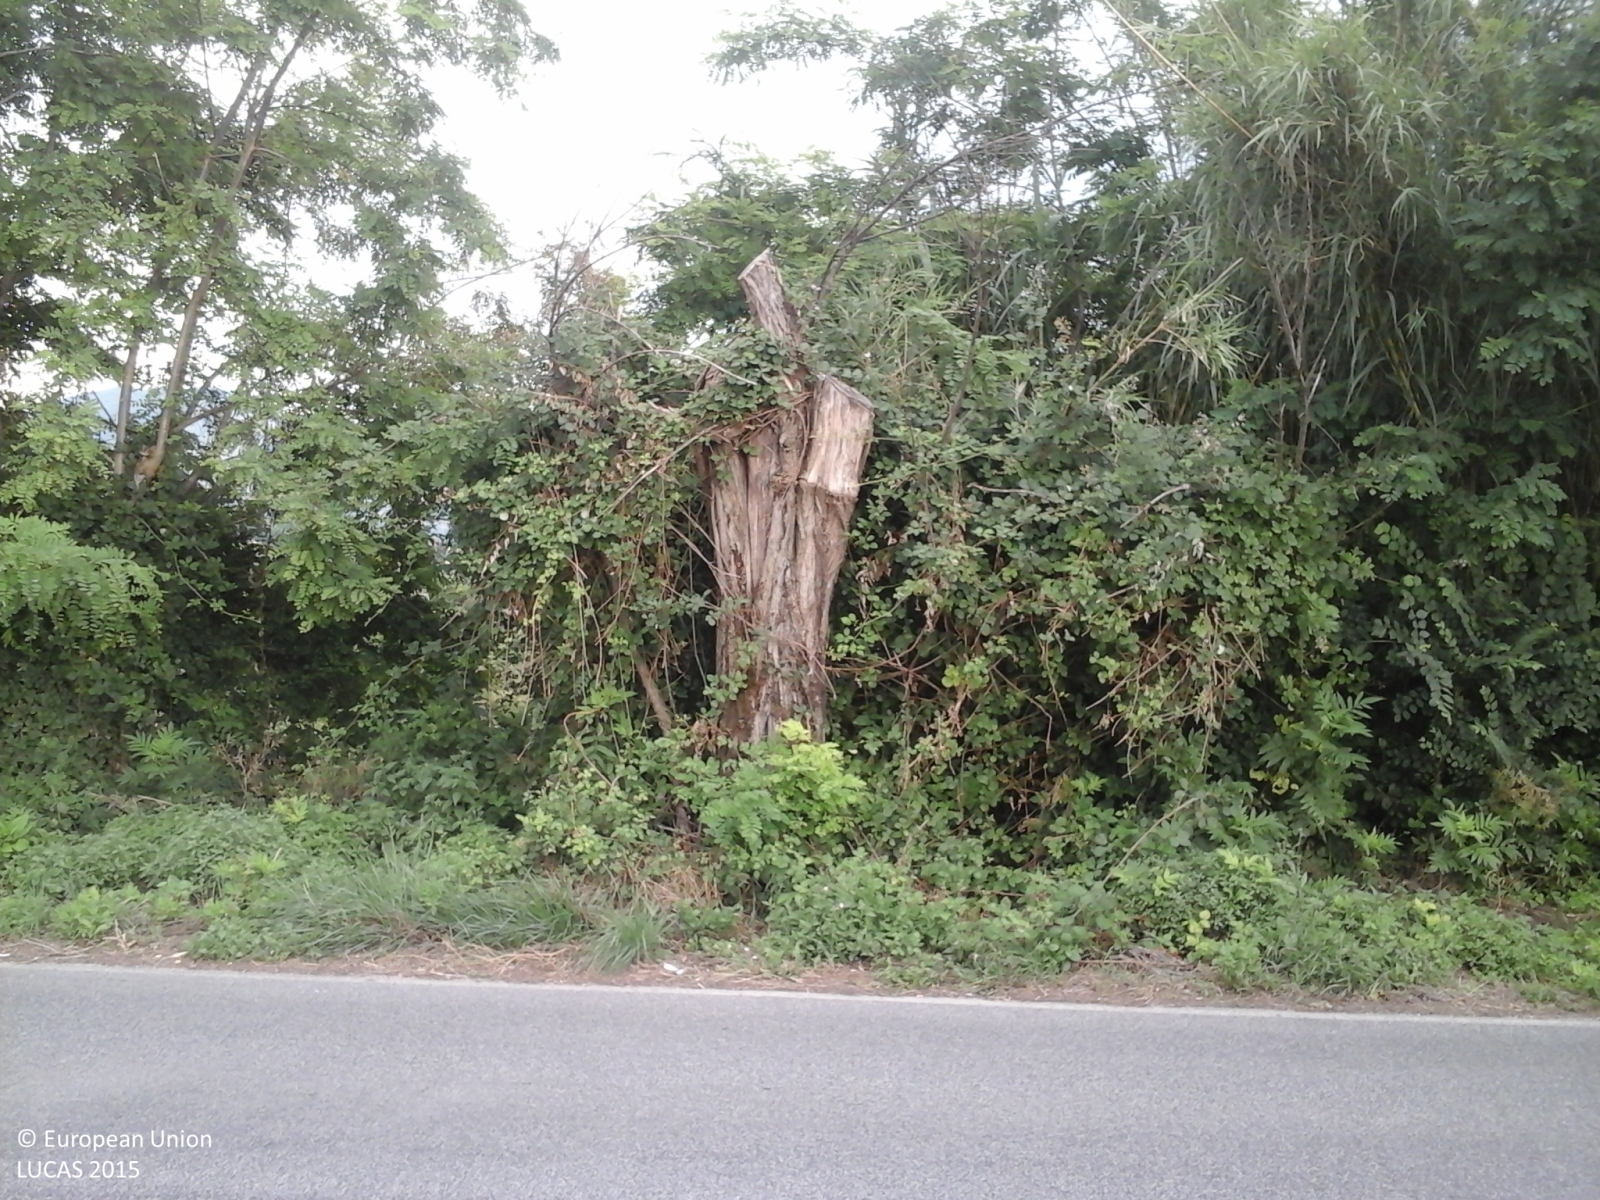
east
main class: Grassland
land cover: Grassland without tree/shrub cover
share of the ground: > 75 %
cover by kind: herbaceous plants 100 %
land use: Residential
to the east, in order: Grassland without tree/shrub cover; Electric lines; Fences; Grass margins; Paved roads, cycling and walking lanes; Grass margins; Managed hedges; Shrubland with sparse tree cover; Olive groves; Artificial constructions in urban areas; Olive groves; Fences; Abandoned hedges; Tomatoes; Potatoes; Other fresh vegetables; Other fruit trees and berries; Fences; Olive groves; Shruby margins; Olive groves; Tracks; Olive groves
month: June
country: IT
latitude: 41.8297
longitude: 13.0831
